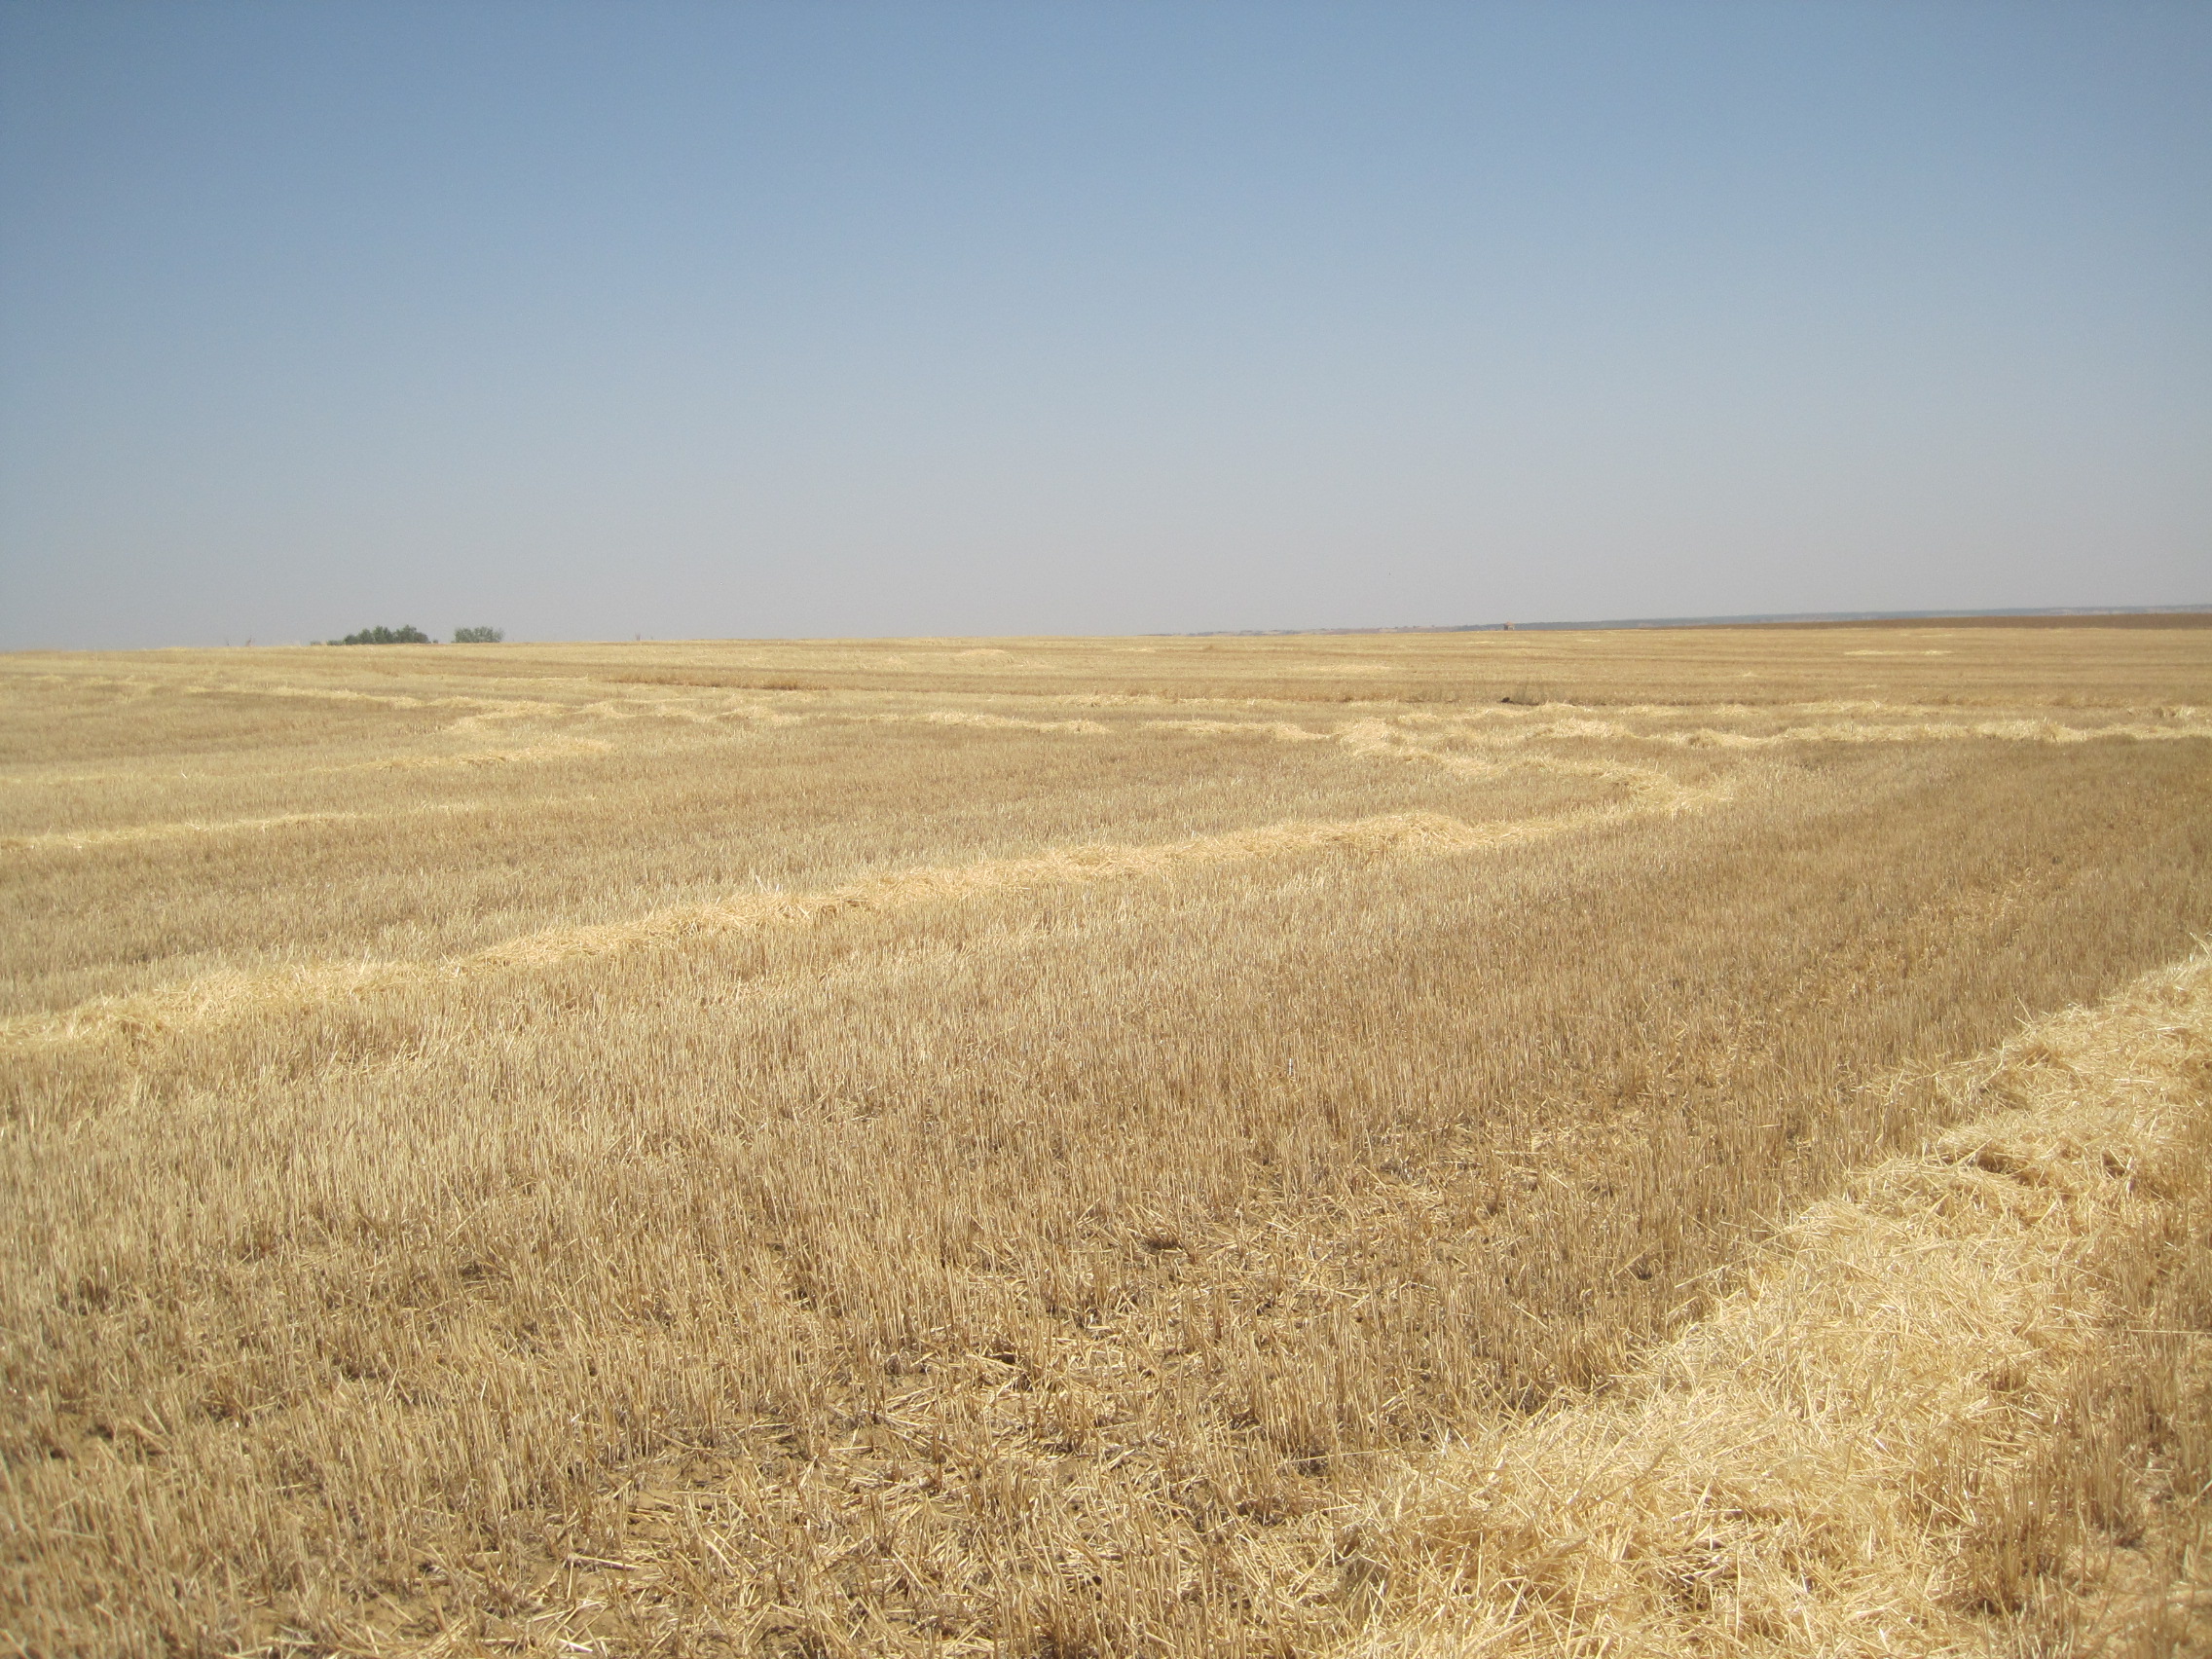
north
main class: Cropland
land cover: Barley
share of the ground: < 10 %
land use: Agriculture (excluding fallow land and kitchen gardens)
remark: Harvested field
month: July
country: ES
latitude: 41.6596
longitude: -5.4665
